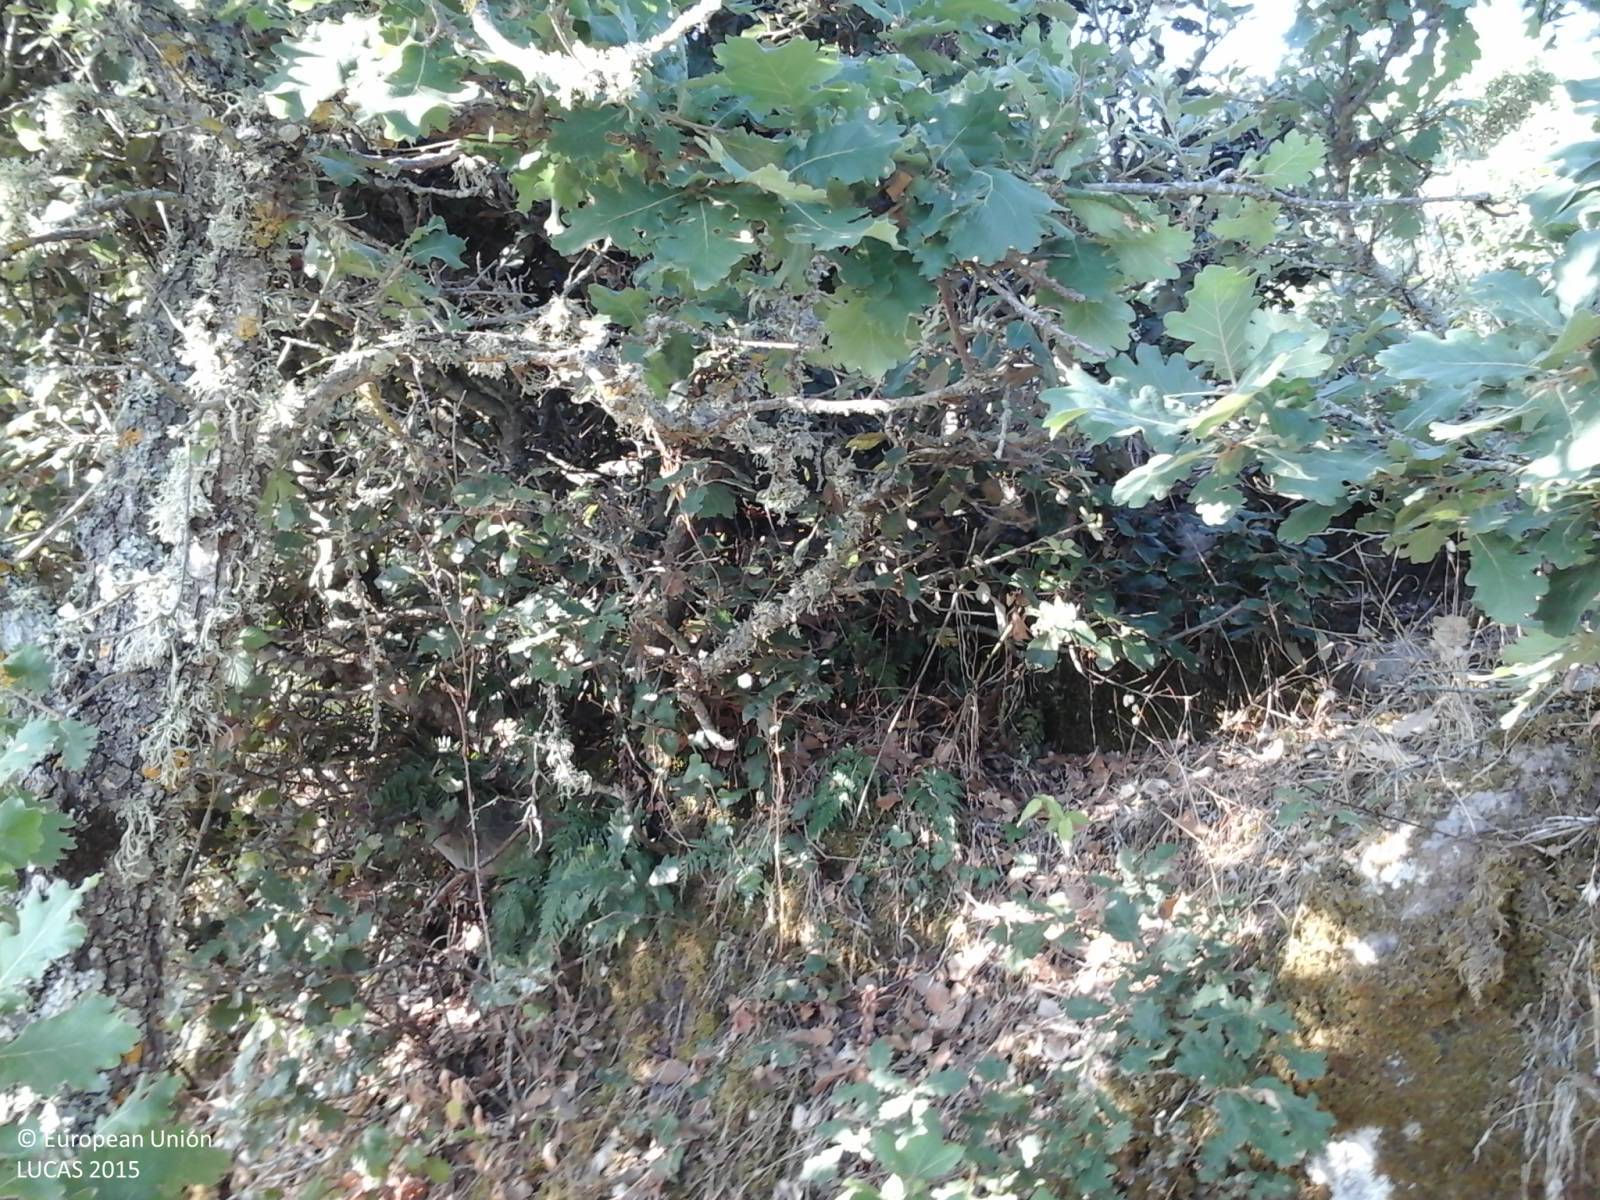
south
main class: Woodland
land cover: Broadleaved woodland
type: thermophilous deciduous forest
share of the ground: 25 - 50 %
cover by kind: broadleaved forest trees 45 %, herbaceous plants 35 %, shrubs 20 %
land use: Agriculture (excluding fallow land and kitchen gardens)
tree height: < 5 m
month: July
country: IT
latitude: 40.4725
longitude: 8.4626
